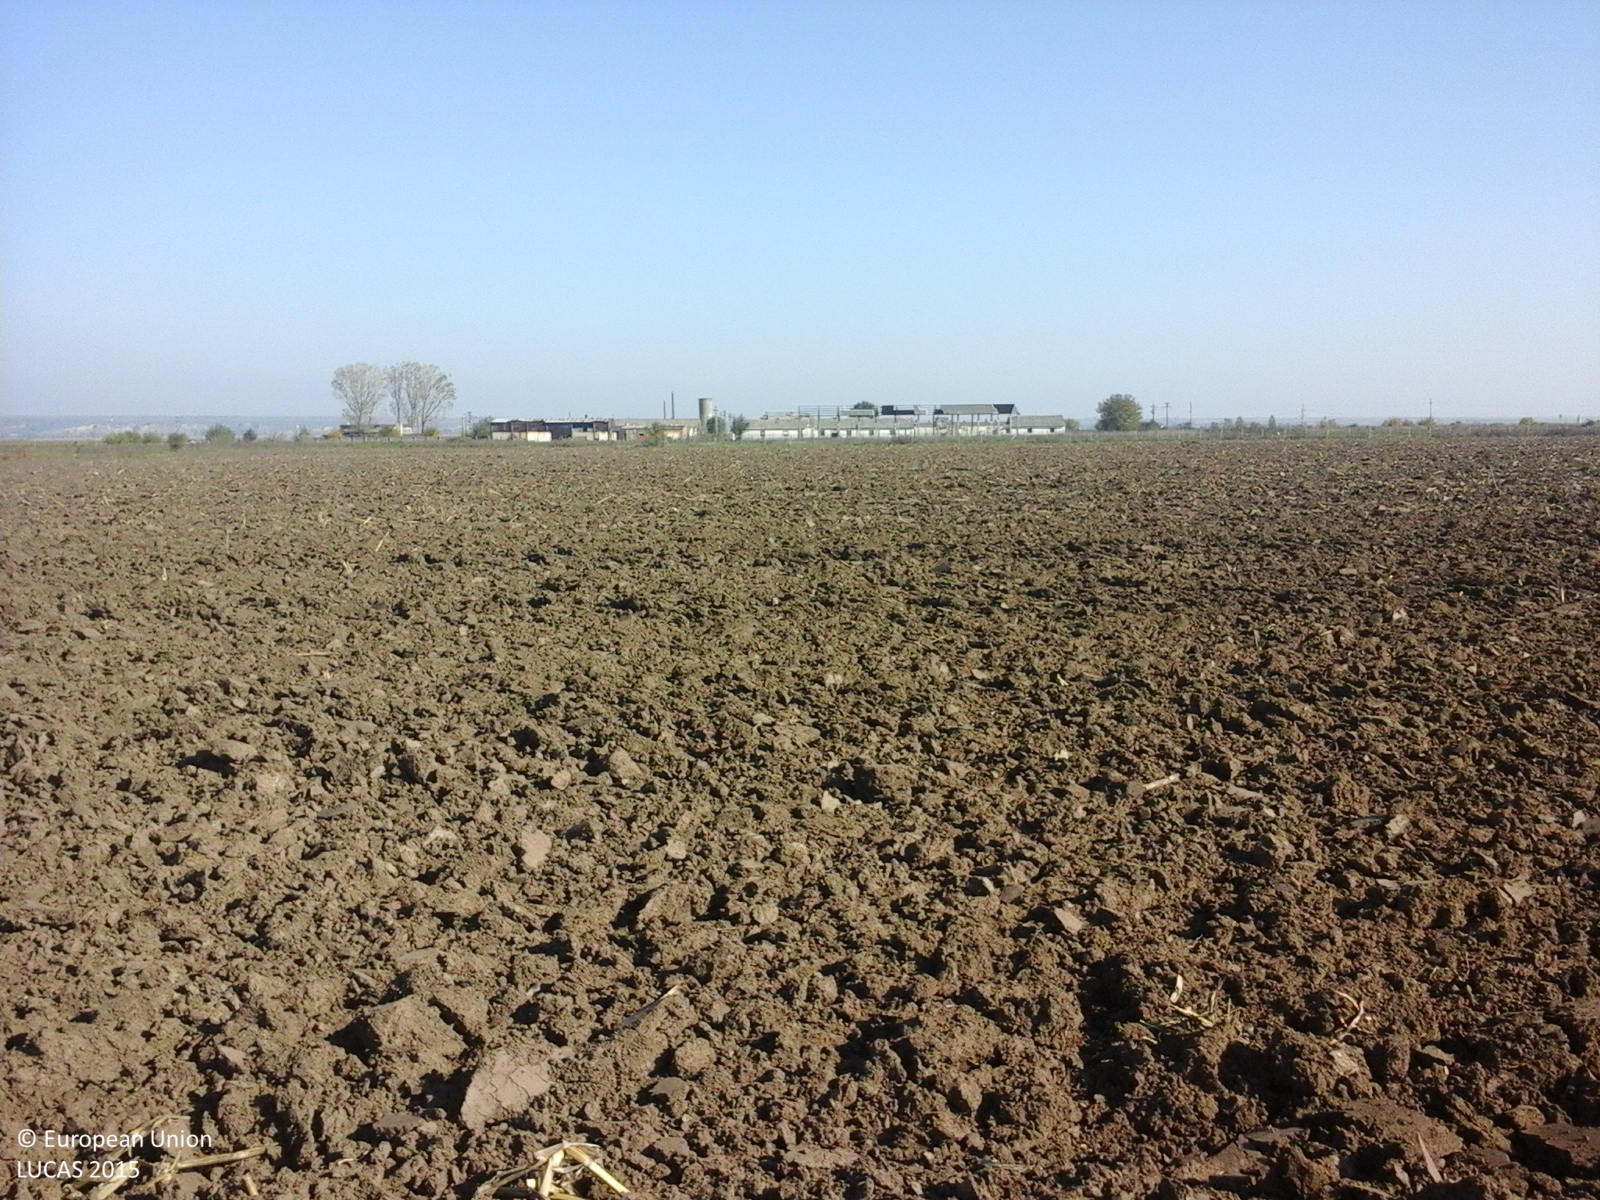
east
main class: Cropland
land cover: Maize
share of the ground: < 10 %
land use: Agriculture (excluding fallow land and kitchen gardens)
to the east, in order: Maize; Fences; Grassland without tree/shrub cover
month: October
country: RO
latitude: 45.8835
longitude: 27.1957
